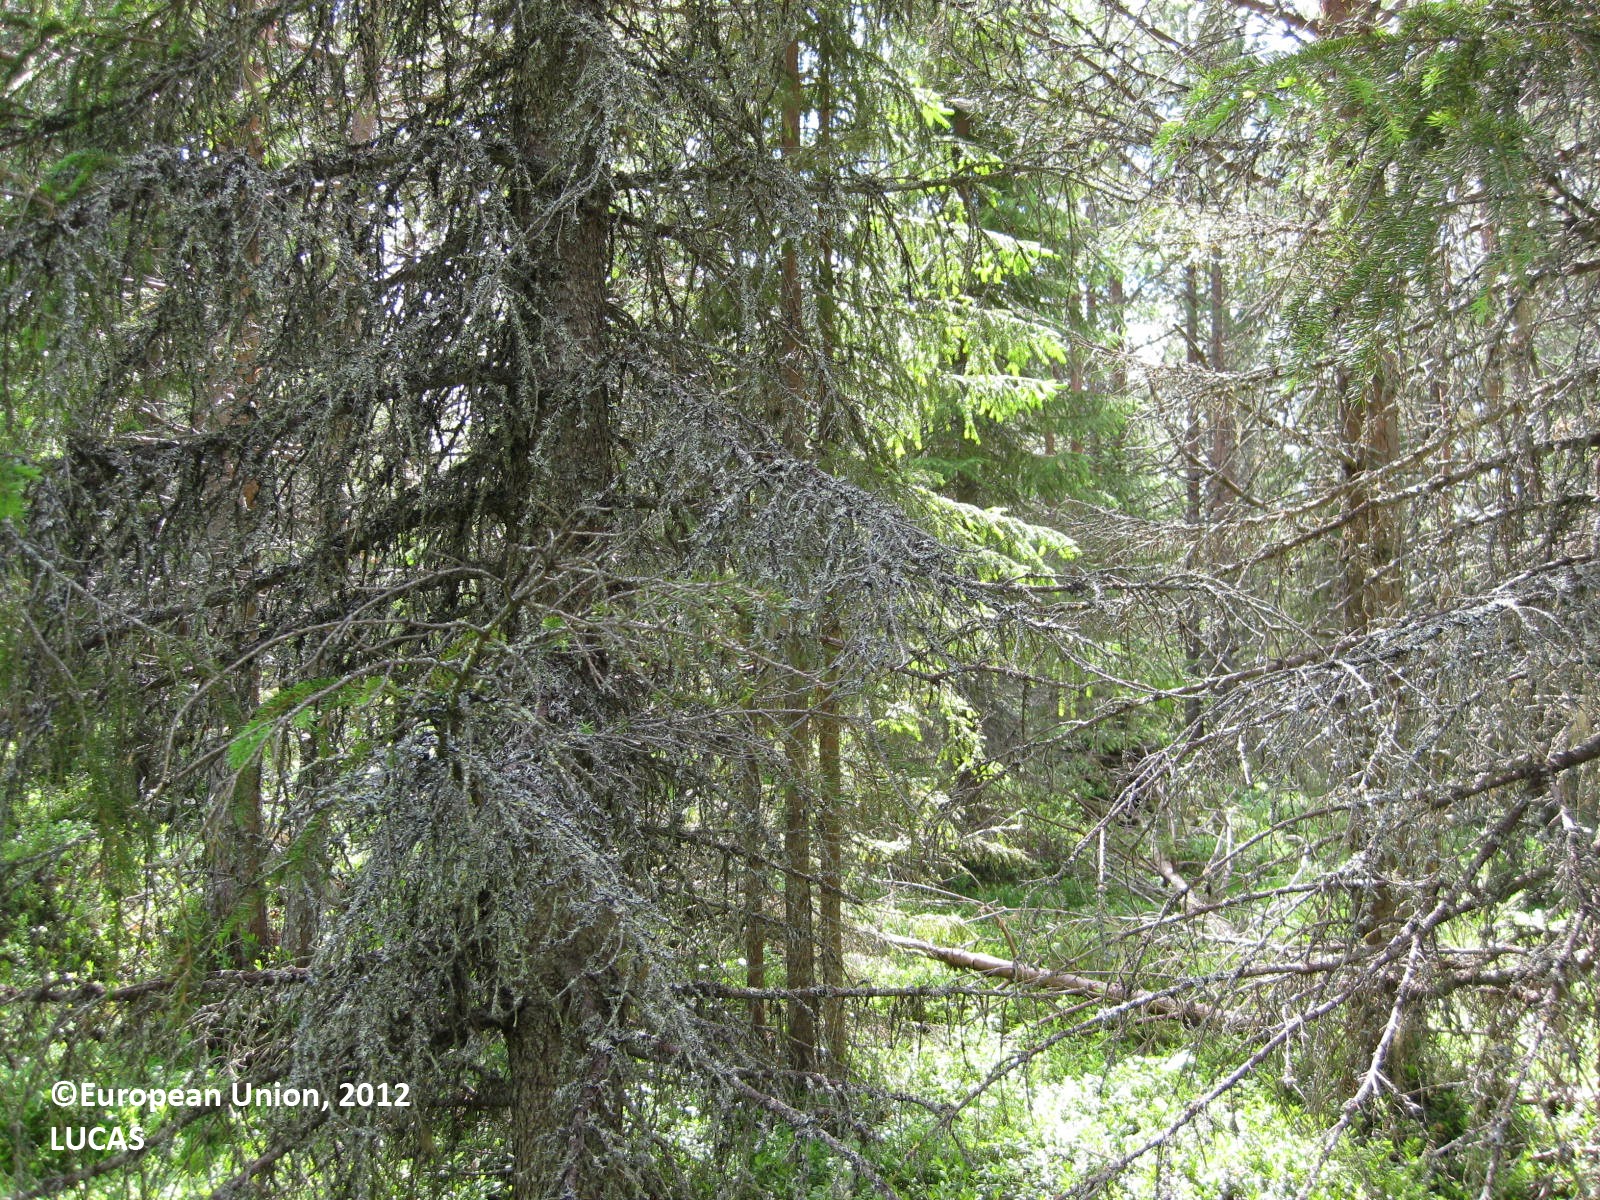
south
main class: Woodland
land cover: Other coniferous woodland
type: boreal forest
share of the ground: 50 - 75 %
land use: Forestry
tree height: > 5 m
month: July
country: FI
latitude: 65.5495
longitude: 29.3541
